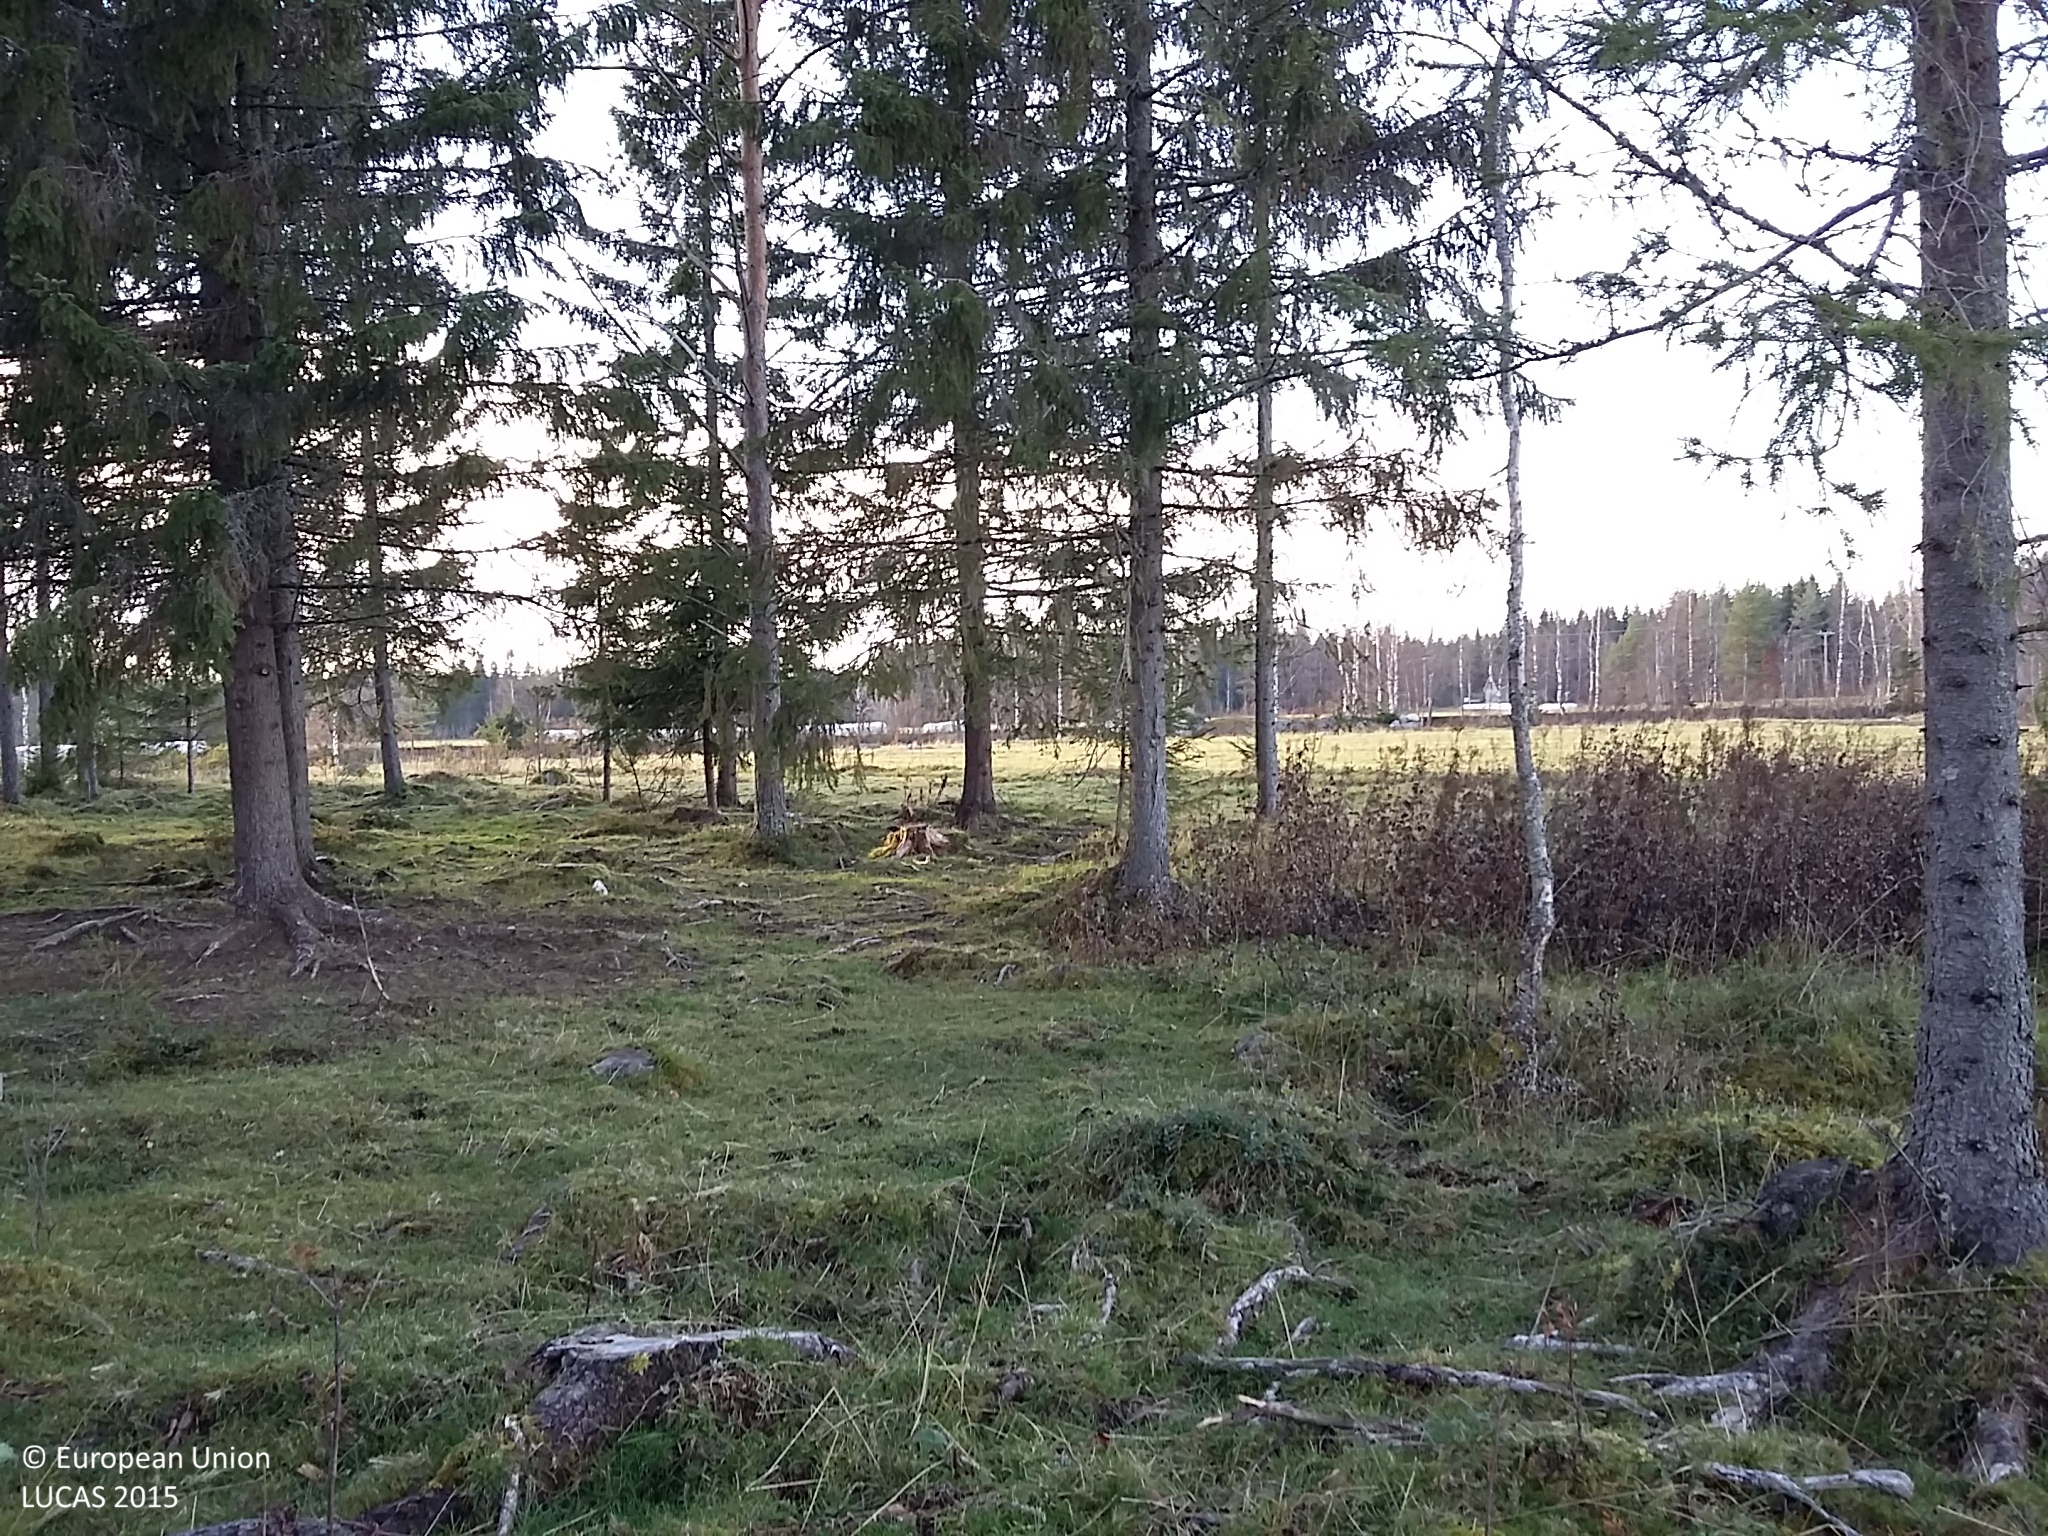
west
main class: Woodland
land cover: Spruce dominated coniferous woodland
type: boreal forest
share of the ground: 25 - 50 %
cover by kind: coniferous forest trees 40 %, shrubs 20 %, herbaceous plants 20 %, lichens and mosses 20 %
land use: Forestry
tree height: > 5 m
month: October
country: FI
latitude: 64.2089
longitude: 25.0597
